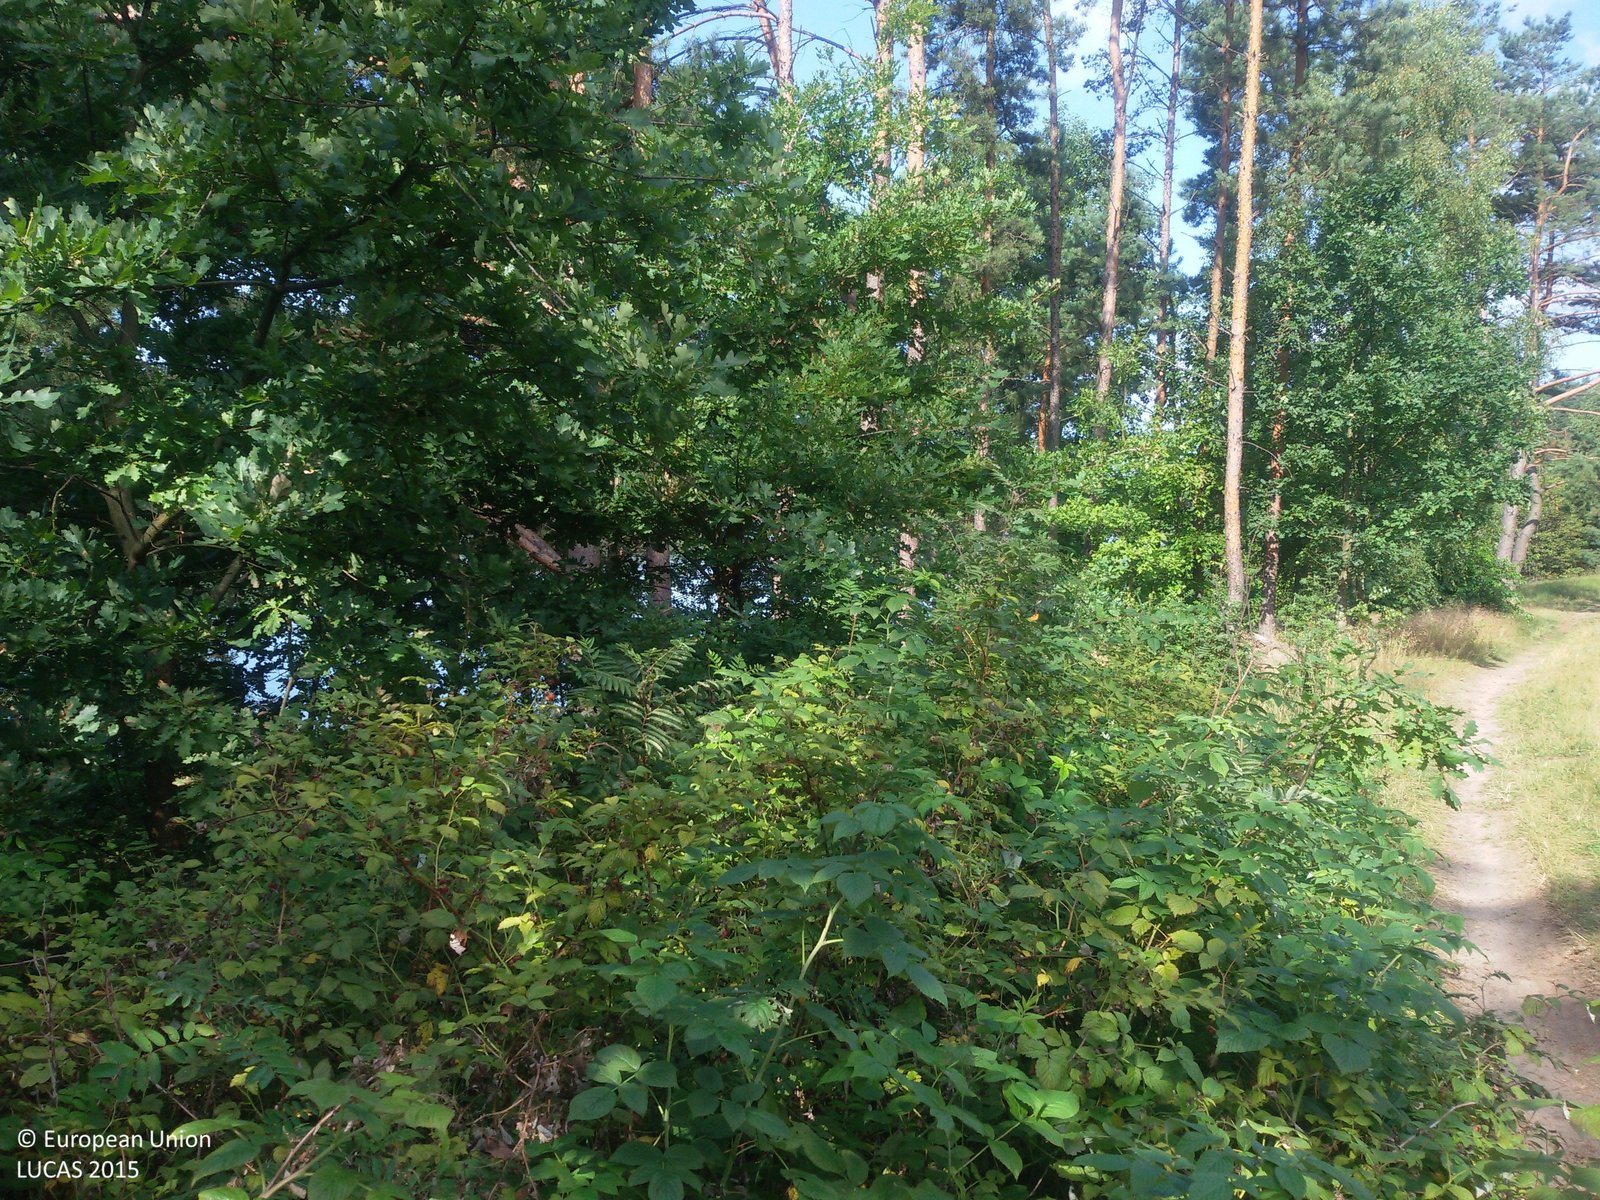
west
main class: Woodland
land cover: Pine dominated mixed woodland
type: hemiboreal forest and nemoral coniferous forest and mixed broadleaved-coniferous forest
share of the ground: > 75 %
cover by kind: coniferous forest trees 50 %, broadleaved forest trees 35 %, shrubs 10 %, herbaceous plants 5 %
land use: Forestry
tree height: > 5 m
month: August
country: PL
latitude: 54.2128
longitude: 17.8486
